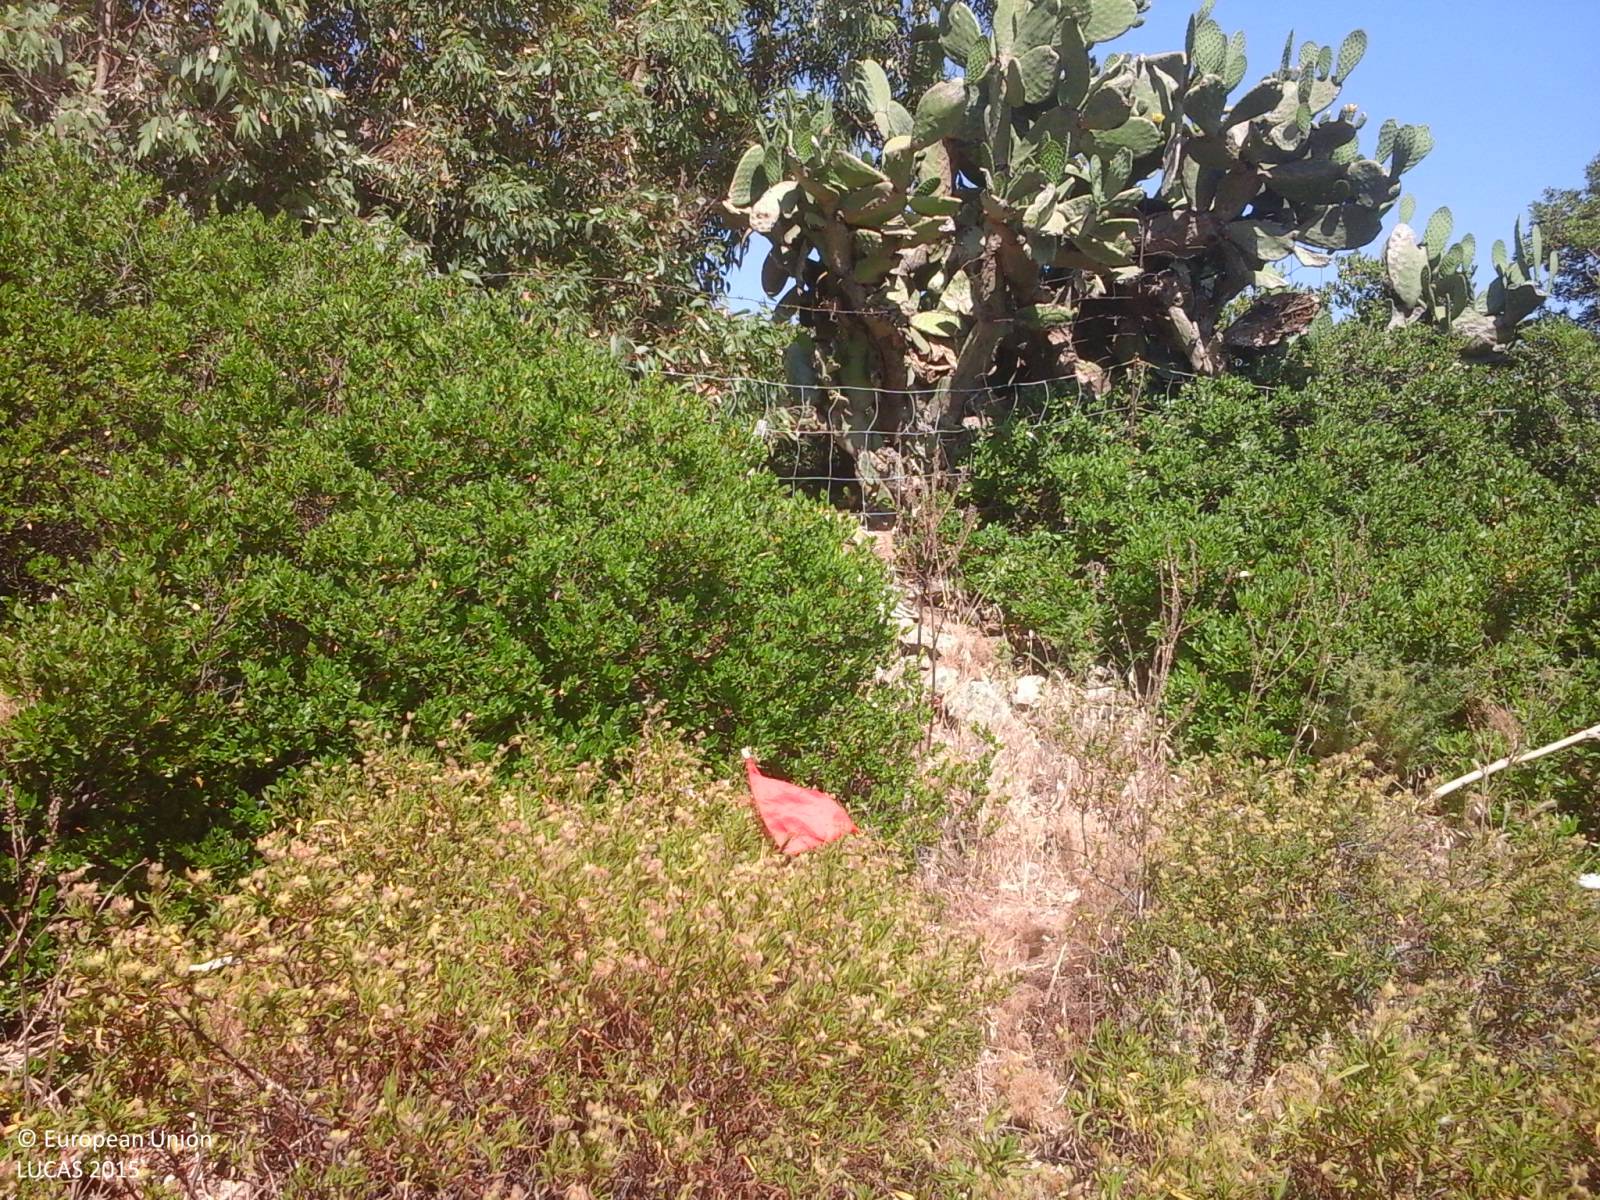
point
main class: Shrubland
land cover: Shrubland with sparse tree cover
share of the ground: > 75 %
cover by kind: shrubs 40 %, herbaceous plants 40 %, unconsolidated bare surface 15 %, broadleaved forest trees 5 %
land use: Semi-natural and natural areas not in use
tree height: < 5 m
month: June
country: IT
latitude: 39.3226
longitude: 9.2506
